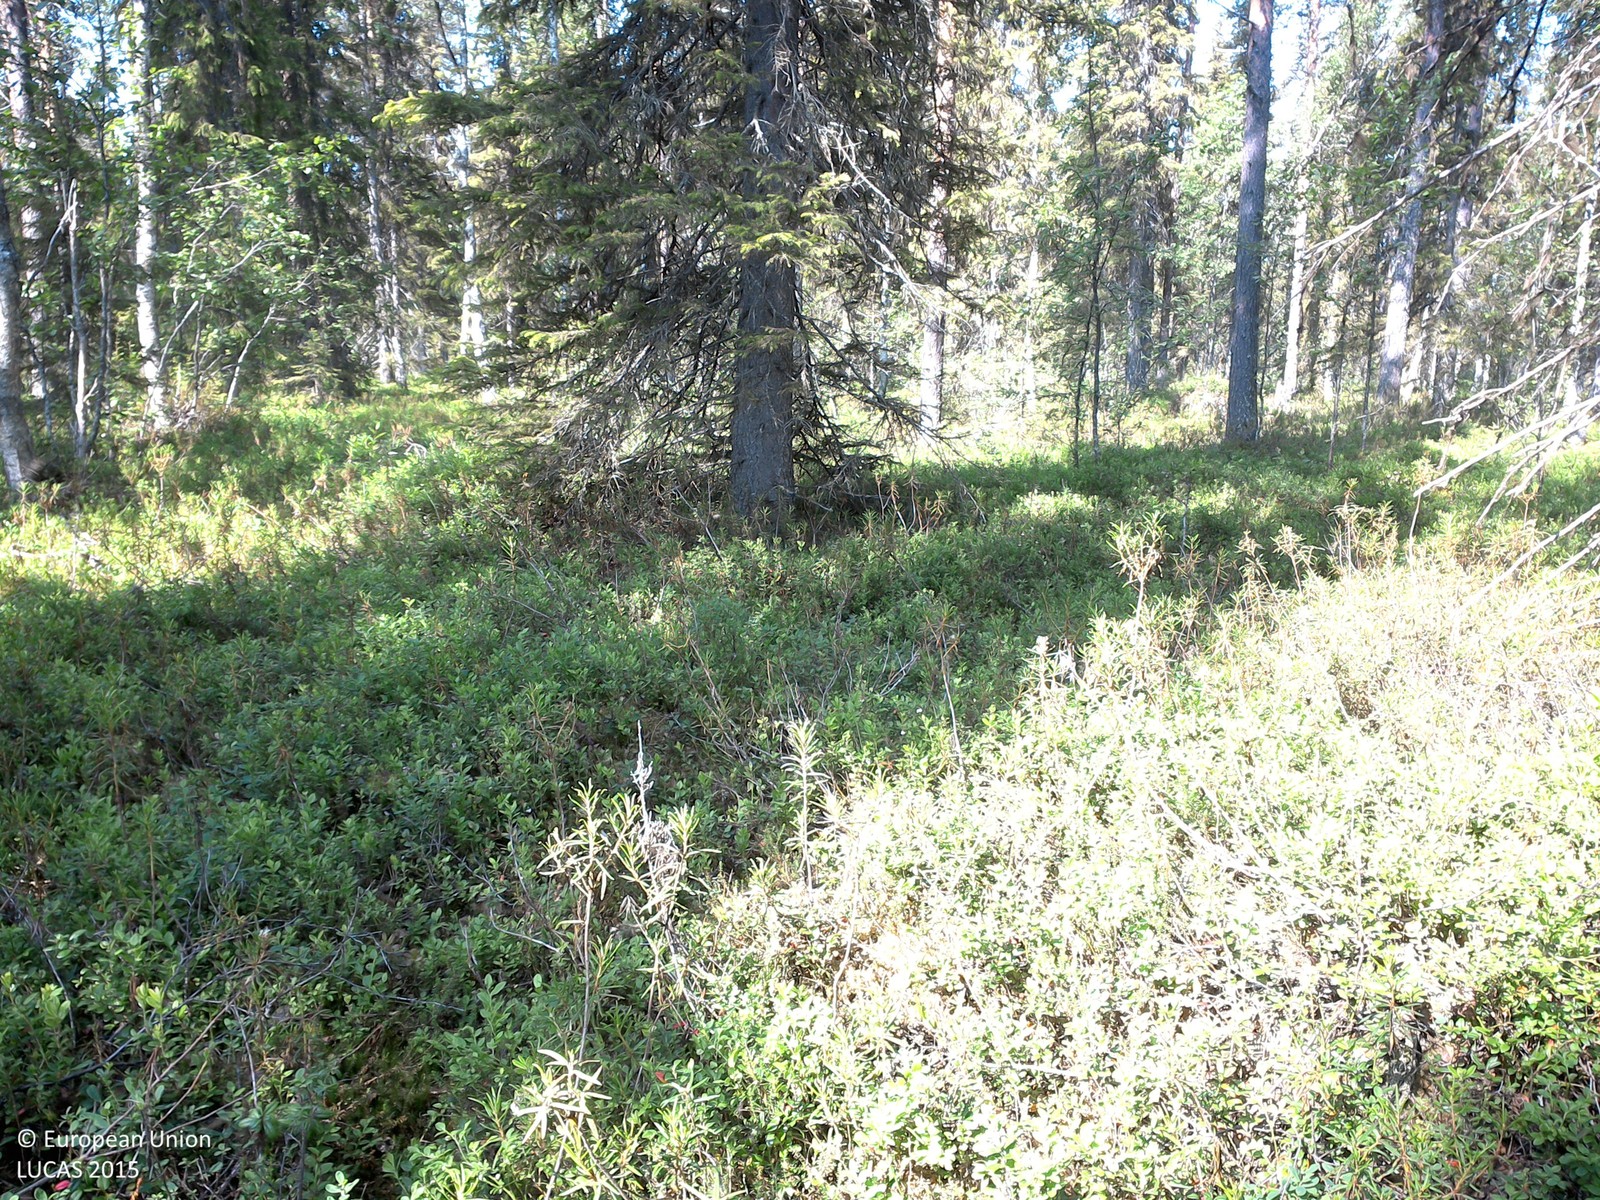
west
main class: Woodland
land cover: Spruce dominated mixed woodland
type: boreal forest
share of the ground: 25 - 50 %
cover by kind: shrubs 60 %, coniferous forest trees 25 %, broadleaved forest trees 10 %, lichens and mosses 5 %
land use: Forestry
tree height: > 5 m
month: July
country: SE
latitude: 66.9564
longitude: 22.9048
